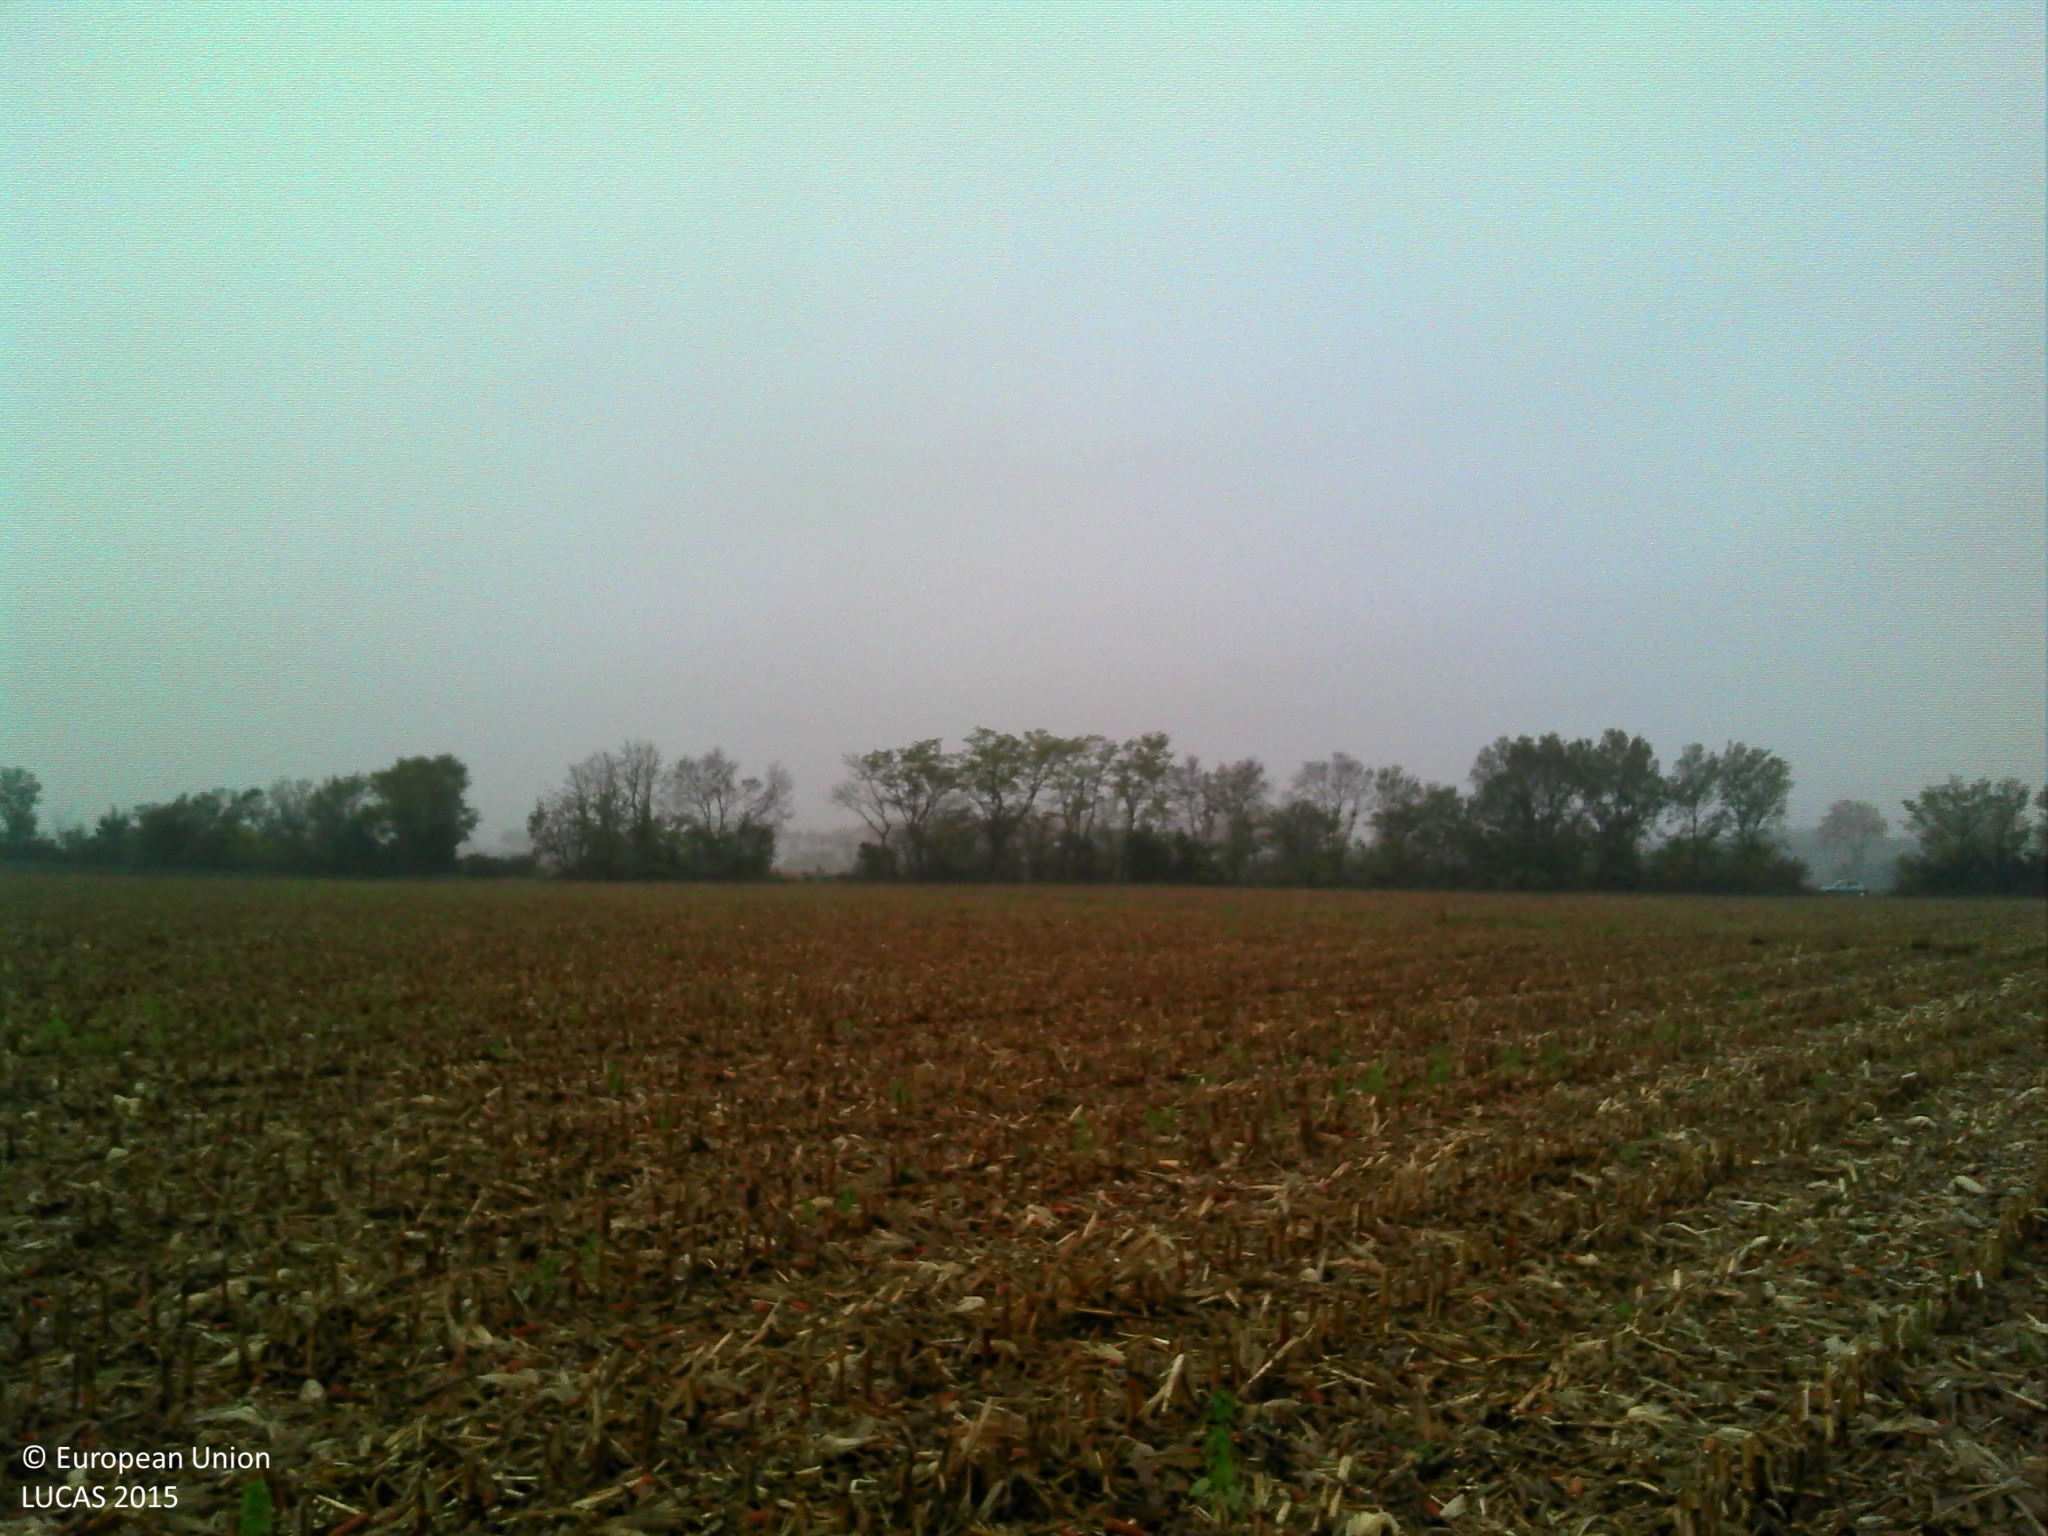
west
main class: Cropland
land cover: Maize
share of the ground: 10 - 25 %
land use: Agriculture (excluding fallow land and kitchen gardens)
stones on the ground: 10 - 25 %
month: December
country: FR
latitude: 45.8813
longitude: 5.1718
